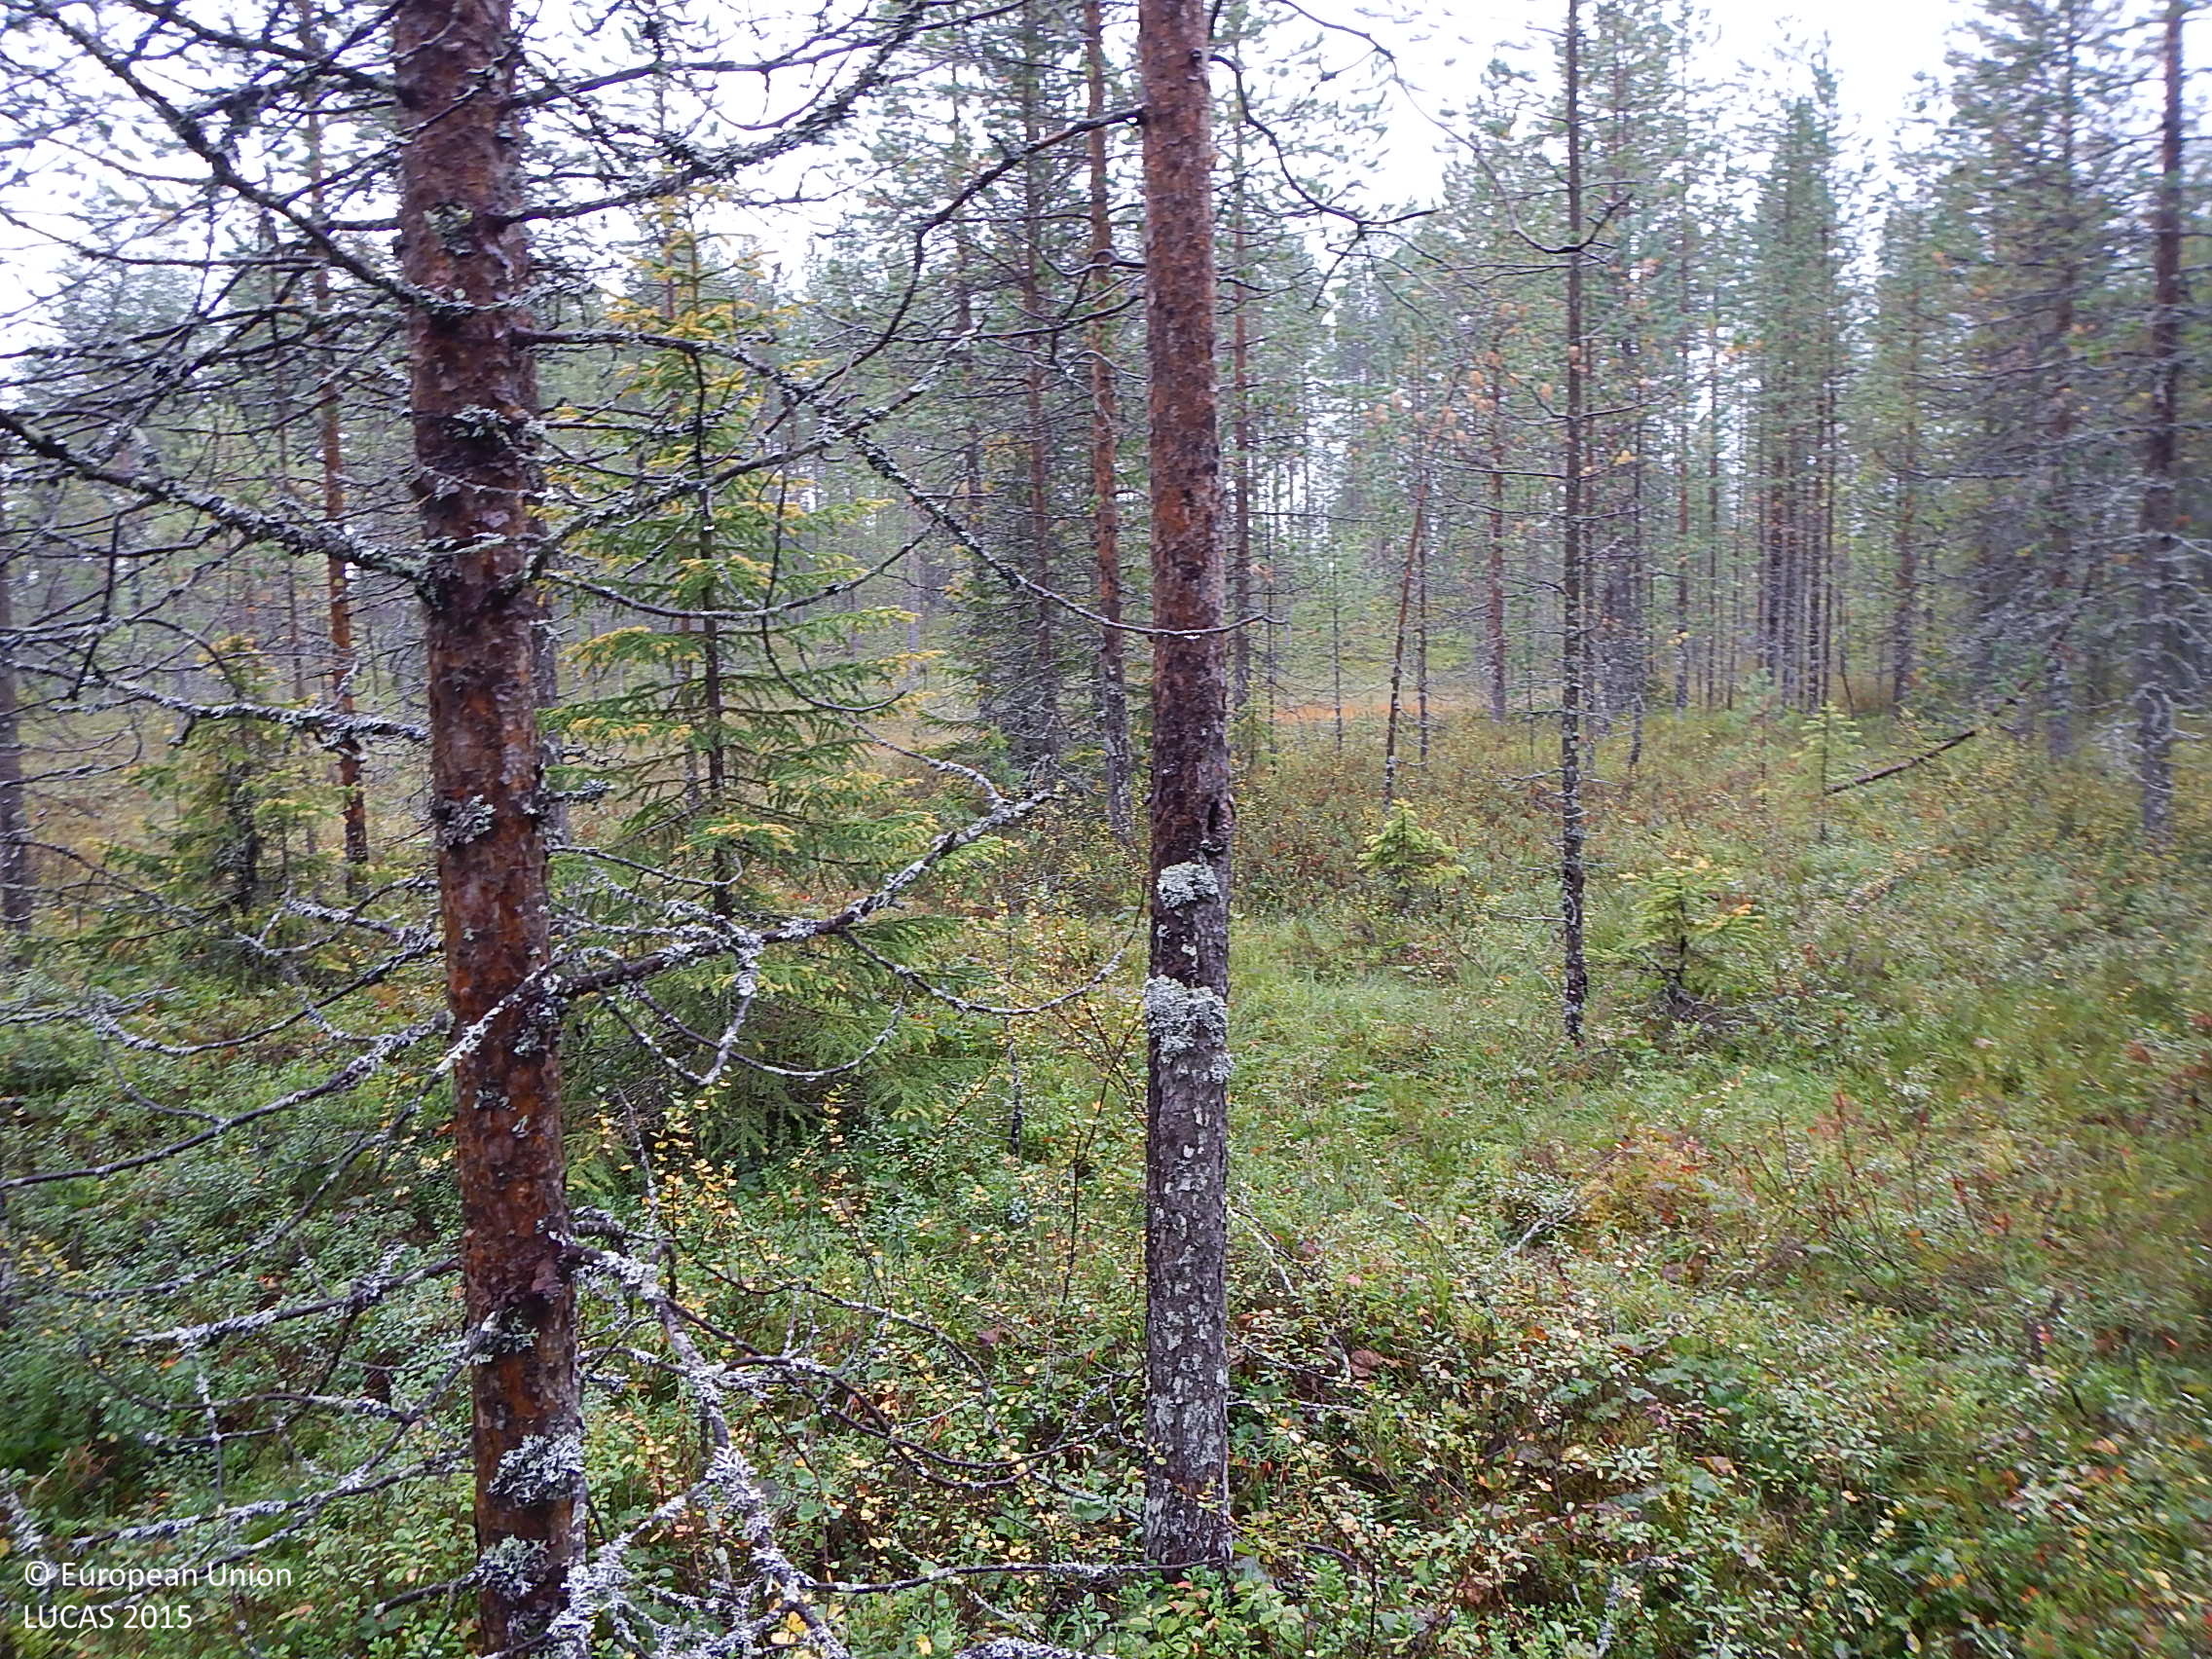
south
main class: Woodland
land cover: Pine dominated coniferous woodland
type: boreal forest
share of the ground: 50 - 75 %
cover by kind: coniferous forest trees 60 %, shrubs 20 %, broadleaved forest trees 10 %, herbaceous plants 10 %
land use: Forestry
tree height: > 5 m
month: August
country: FI
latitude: 65.9762
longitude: 27.3994
